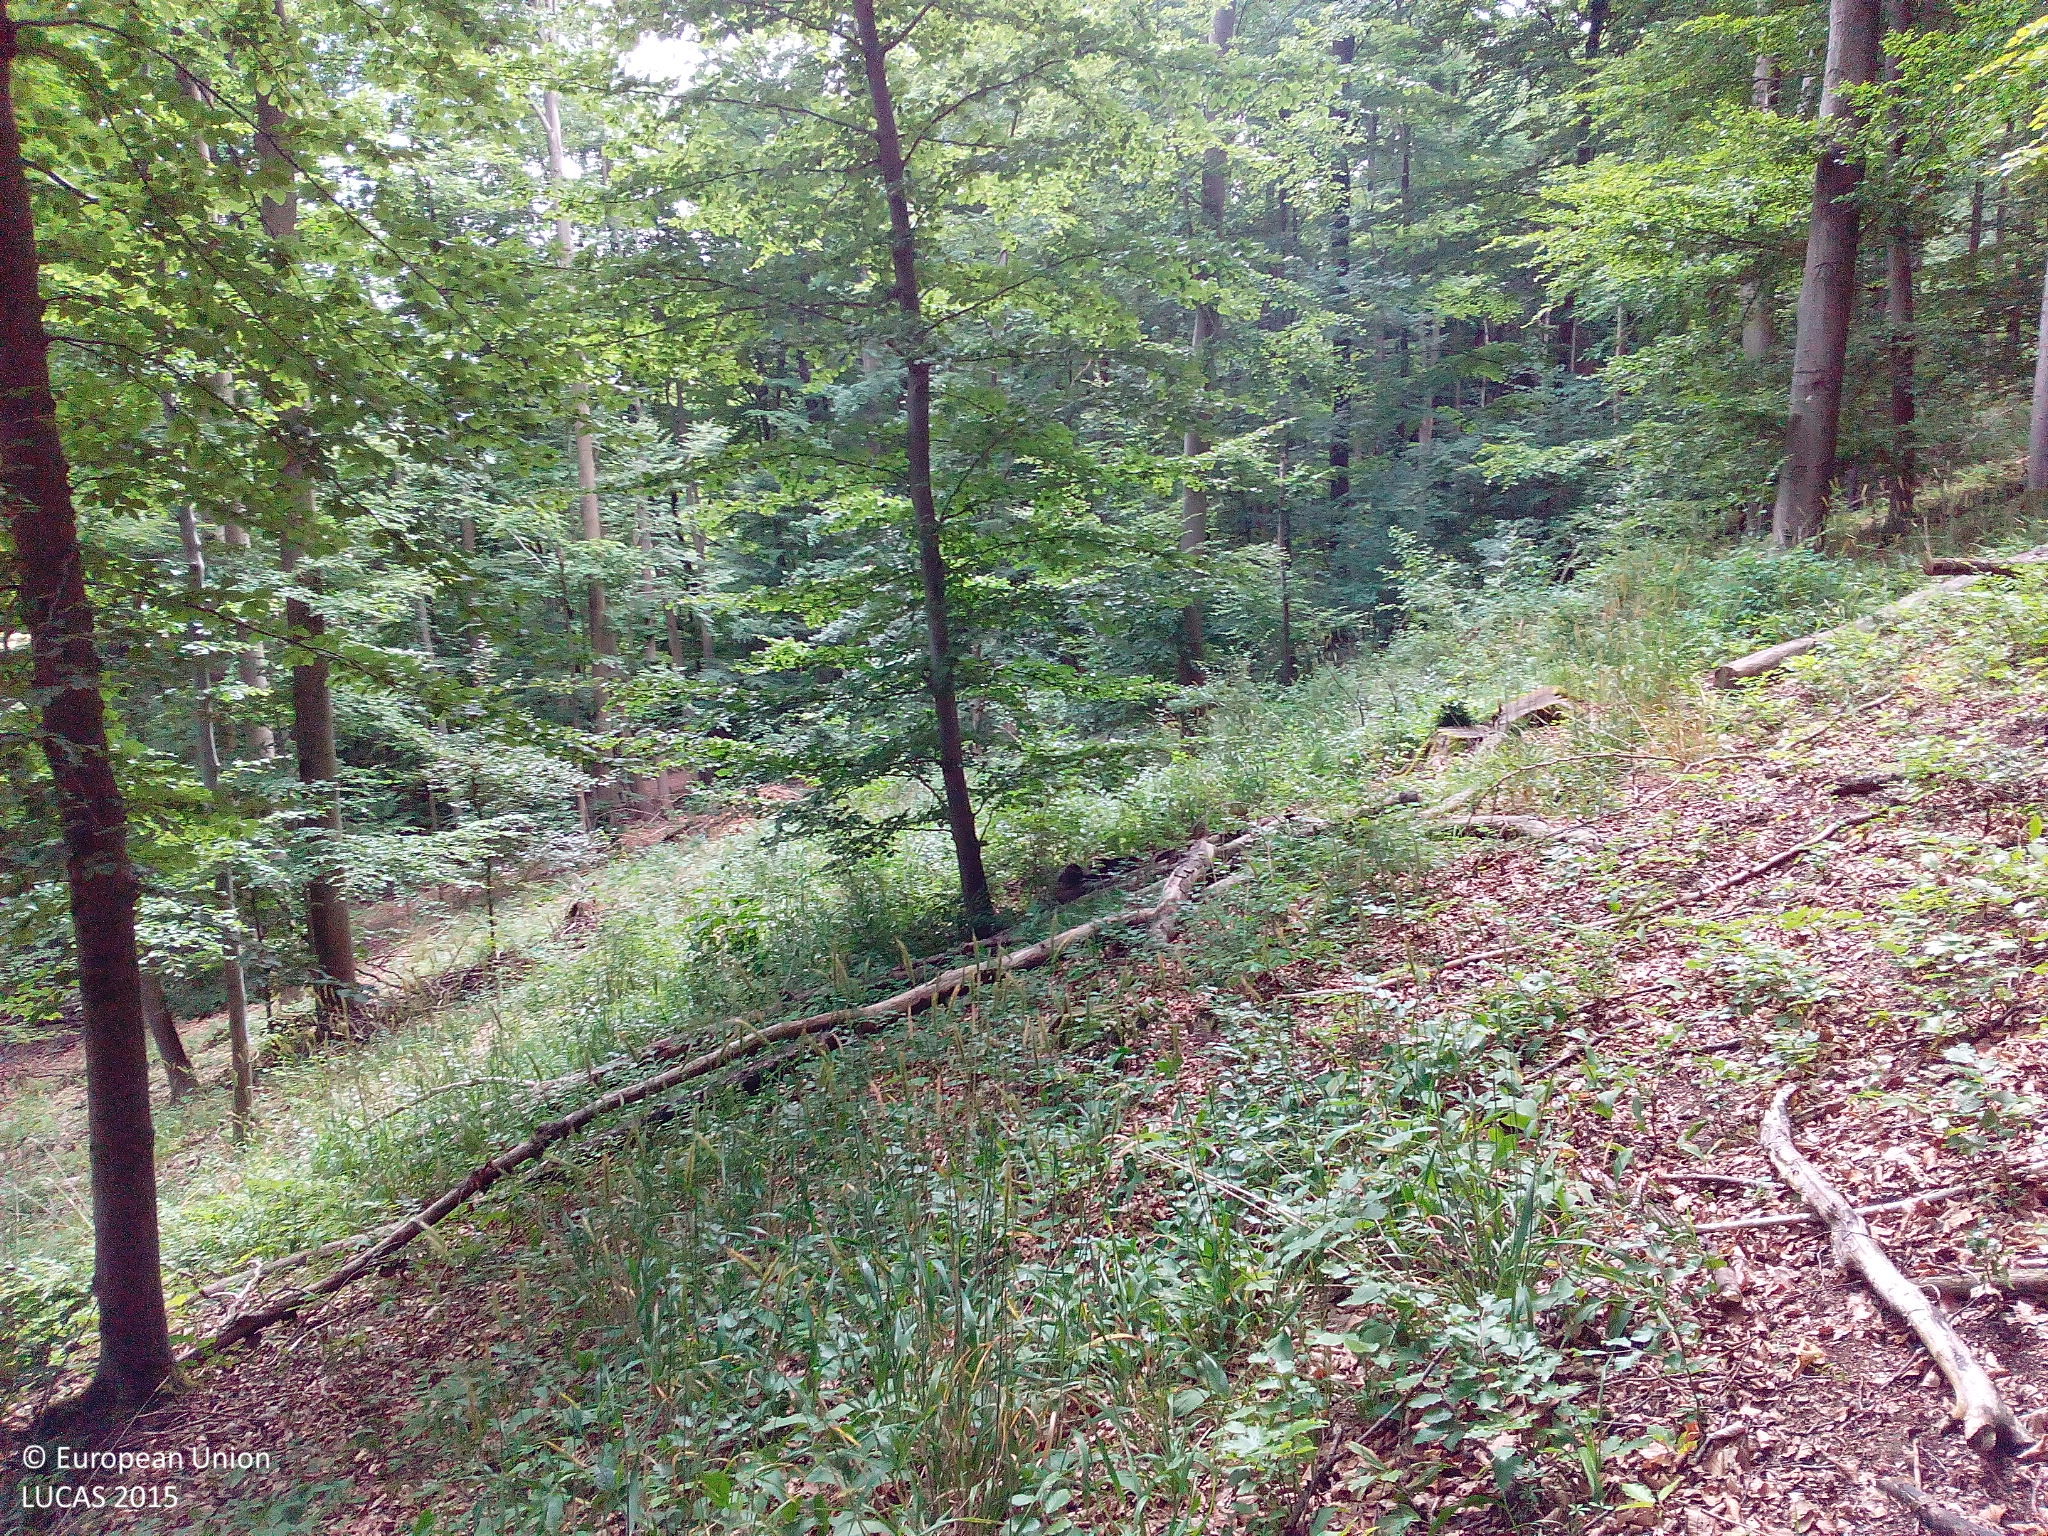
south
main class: Woodland
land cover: Broadleaved woodland
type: beech forest
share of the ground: > 75 %
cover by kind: broadleaved forest trees 90 %, herbaceous plants 5 %, unconsolidated bare surface 5 %
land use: Forestry
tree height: > 5 m
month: July
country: DE
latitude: 50.7416
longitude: 9.9008
